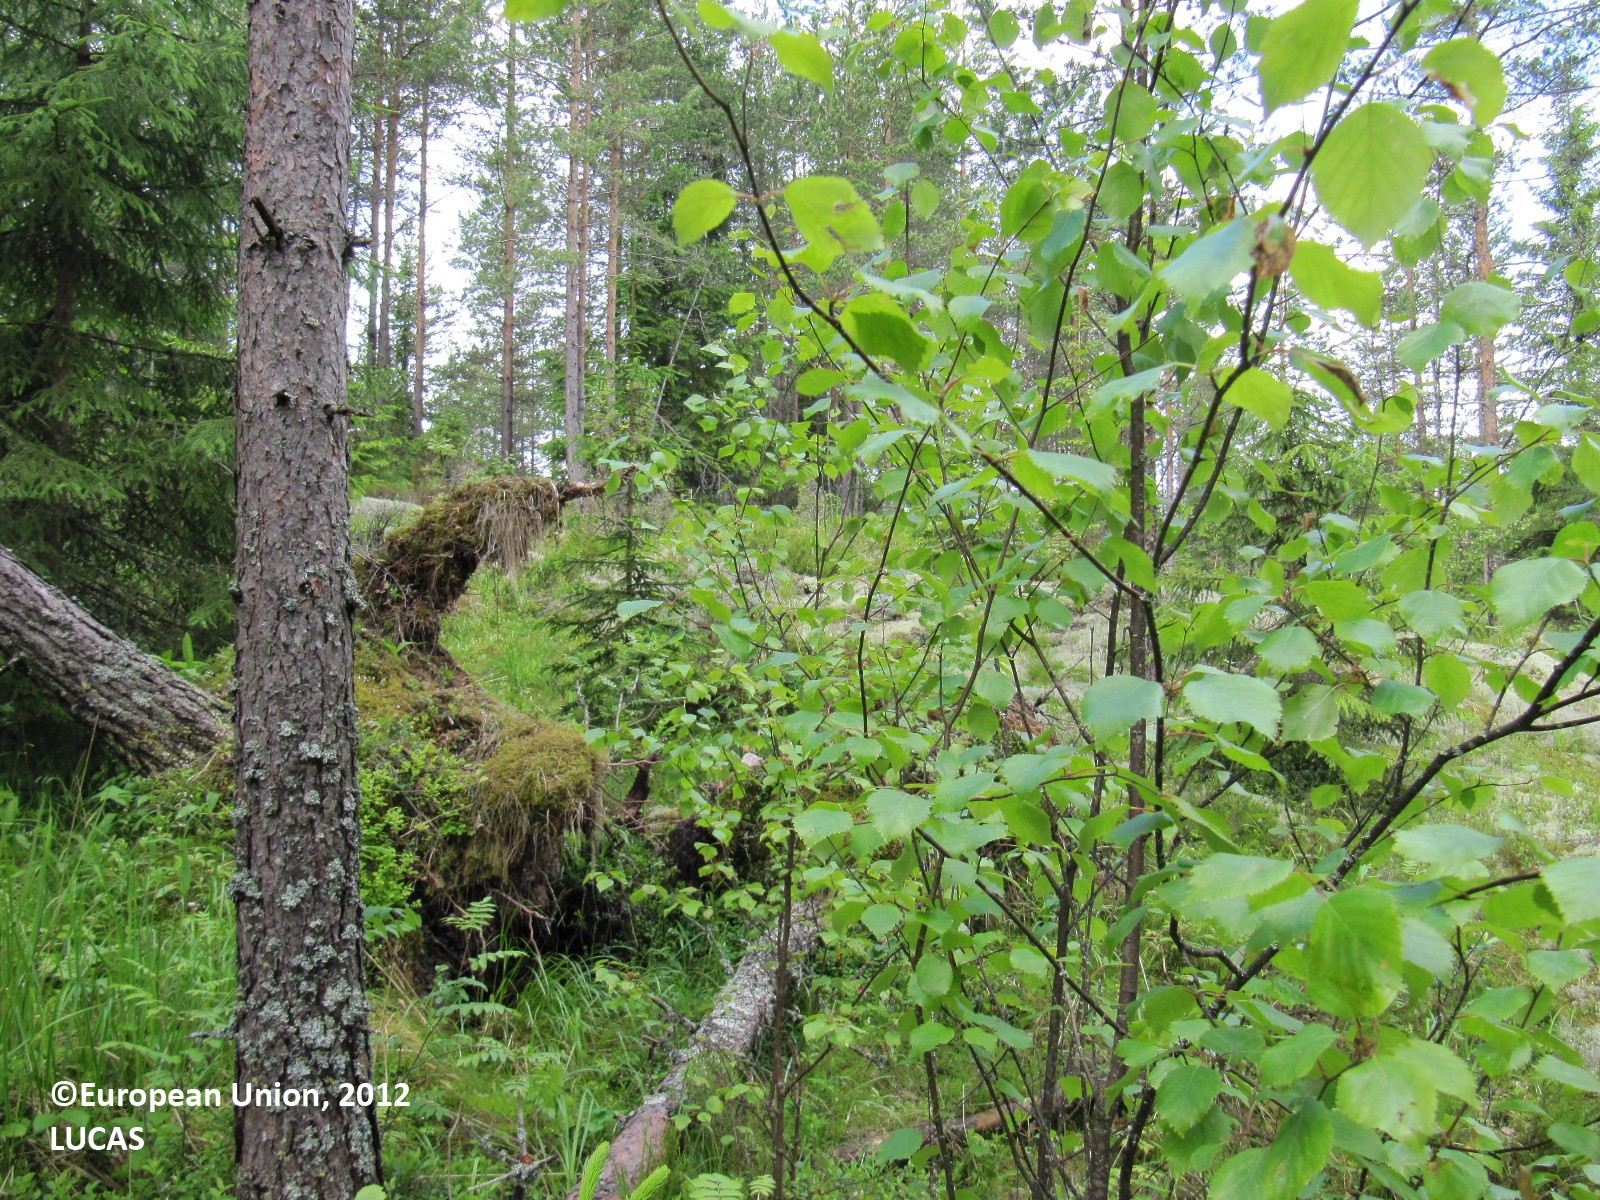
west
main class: Woodland
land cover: Pine dominated coniferous woodland
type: boreal forest
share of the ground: > 75 %
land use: Forestry
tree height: > 5 m
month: June
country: FI
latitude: 60.6107
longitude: 24.0343
